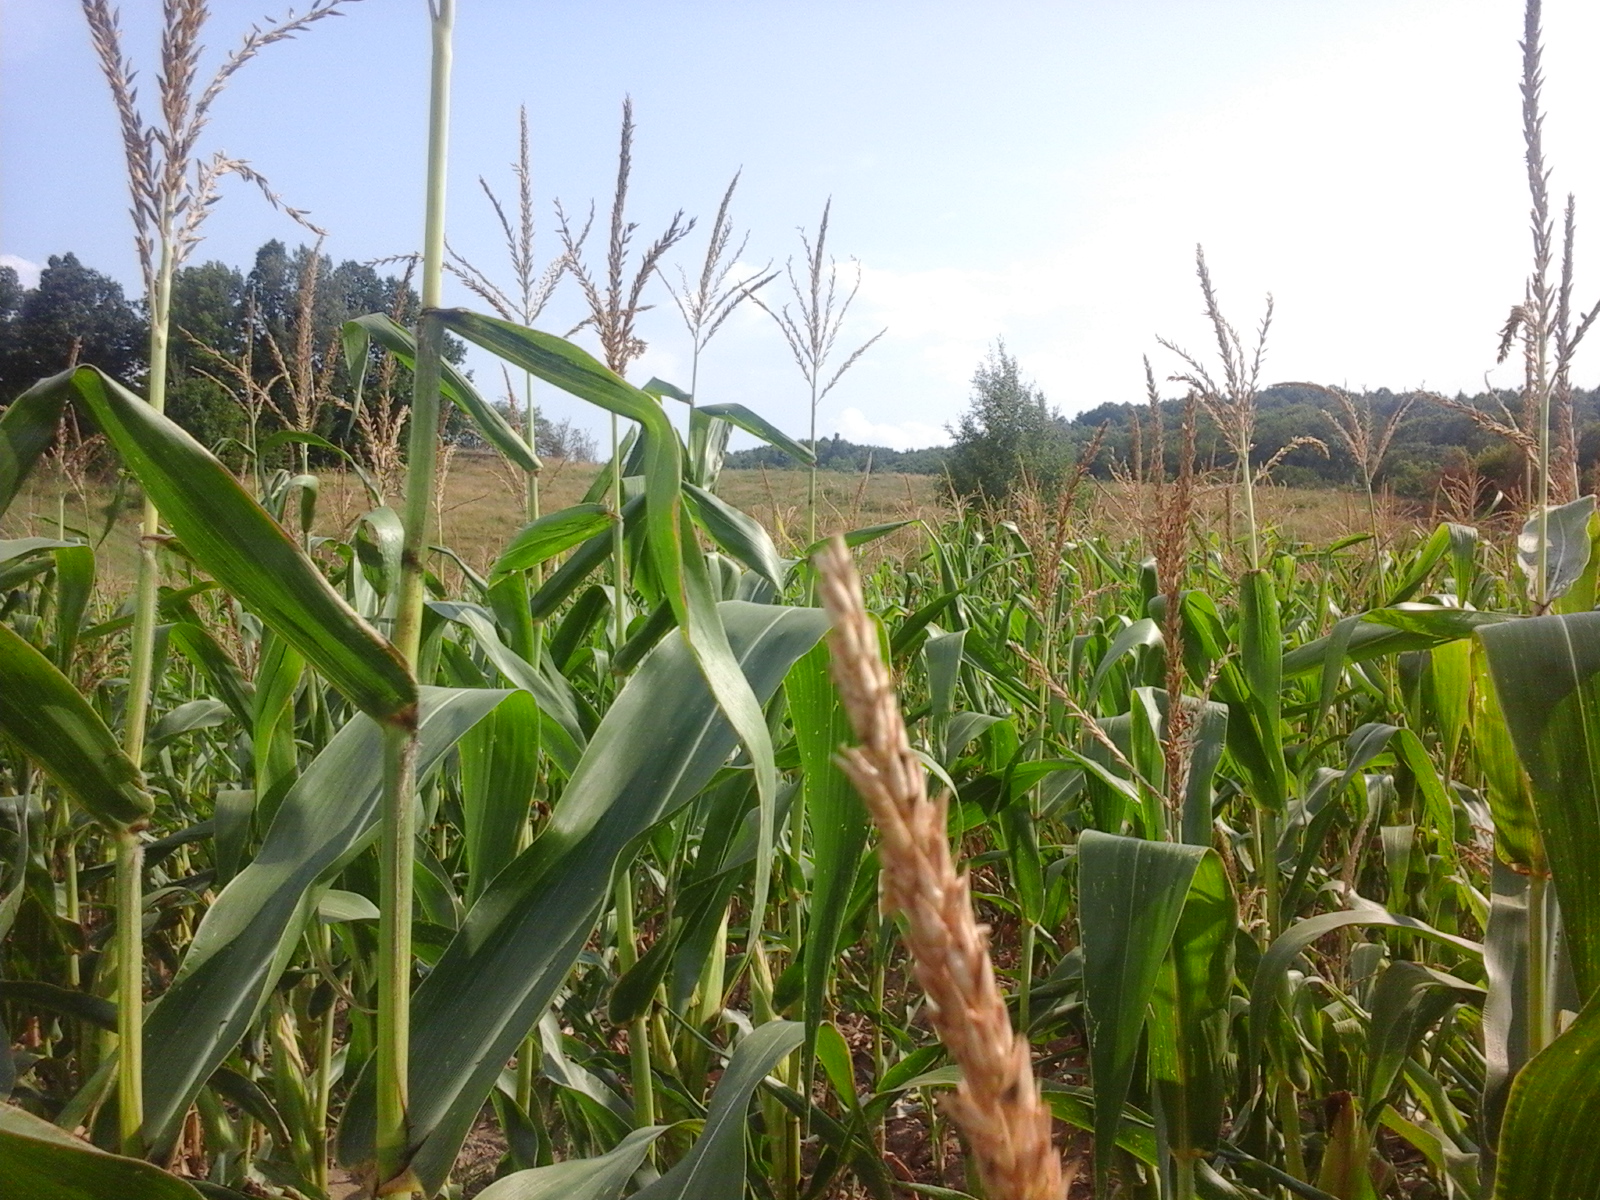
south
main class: Cropland
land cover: Maize
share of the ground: > 75 %
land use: Agriculture (excluding fallow land and kitchen gardens)
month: August
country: RO
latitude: 44.8037
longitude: 23.7264
